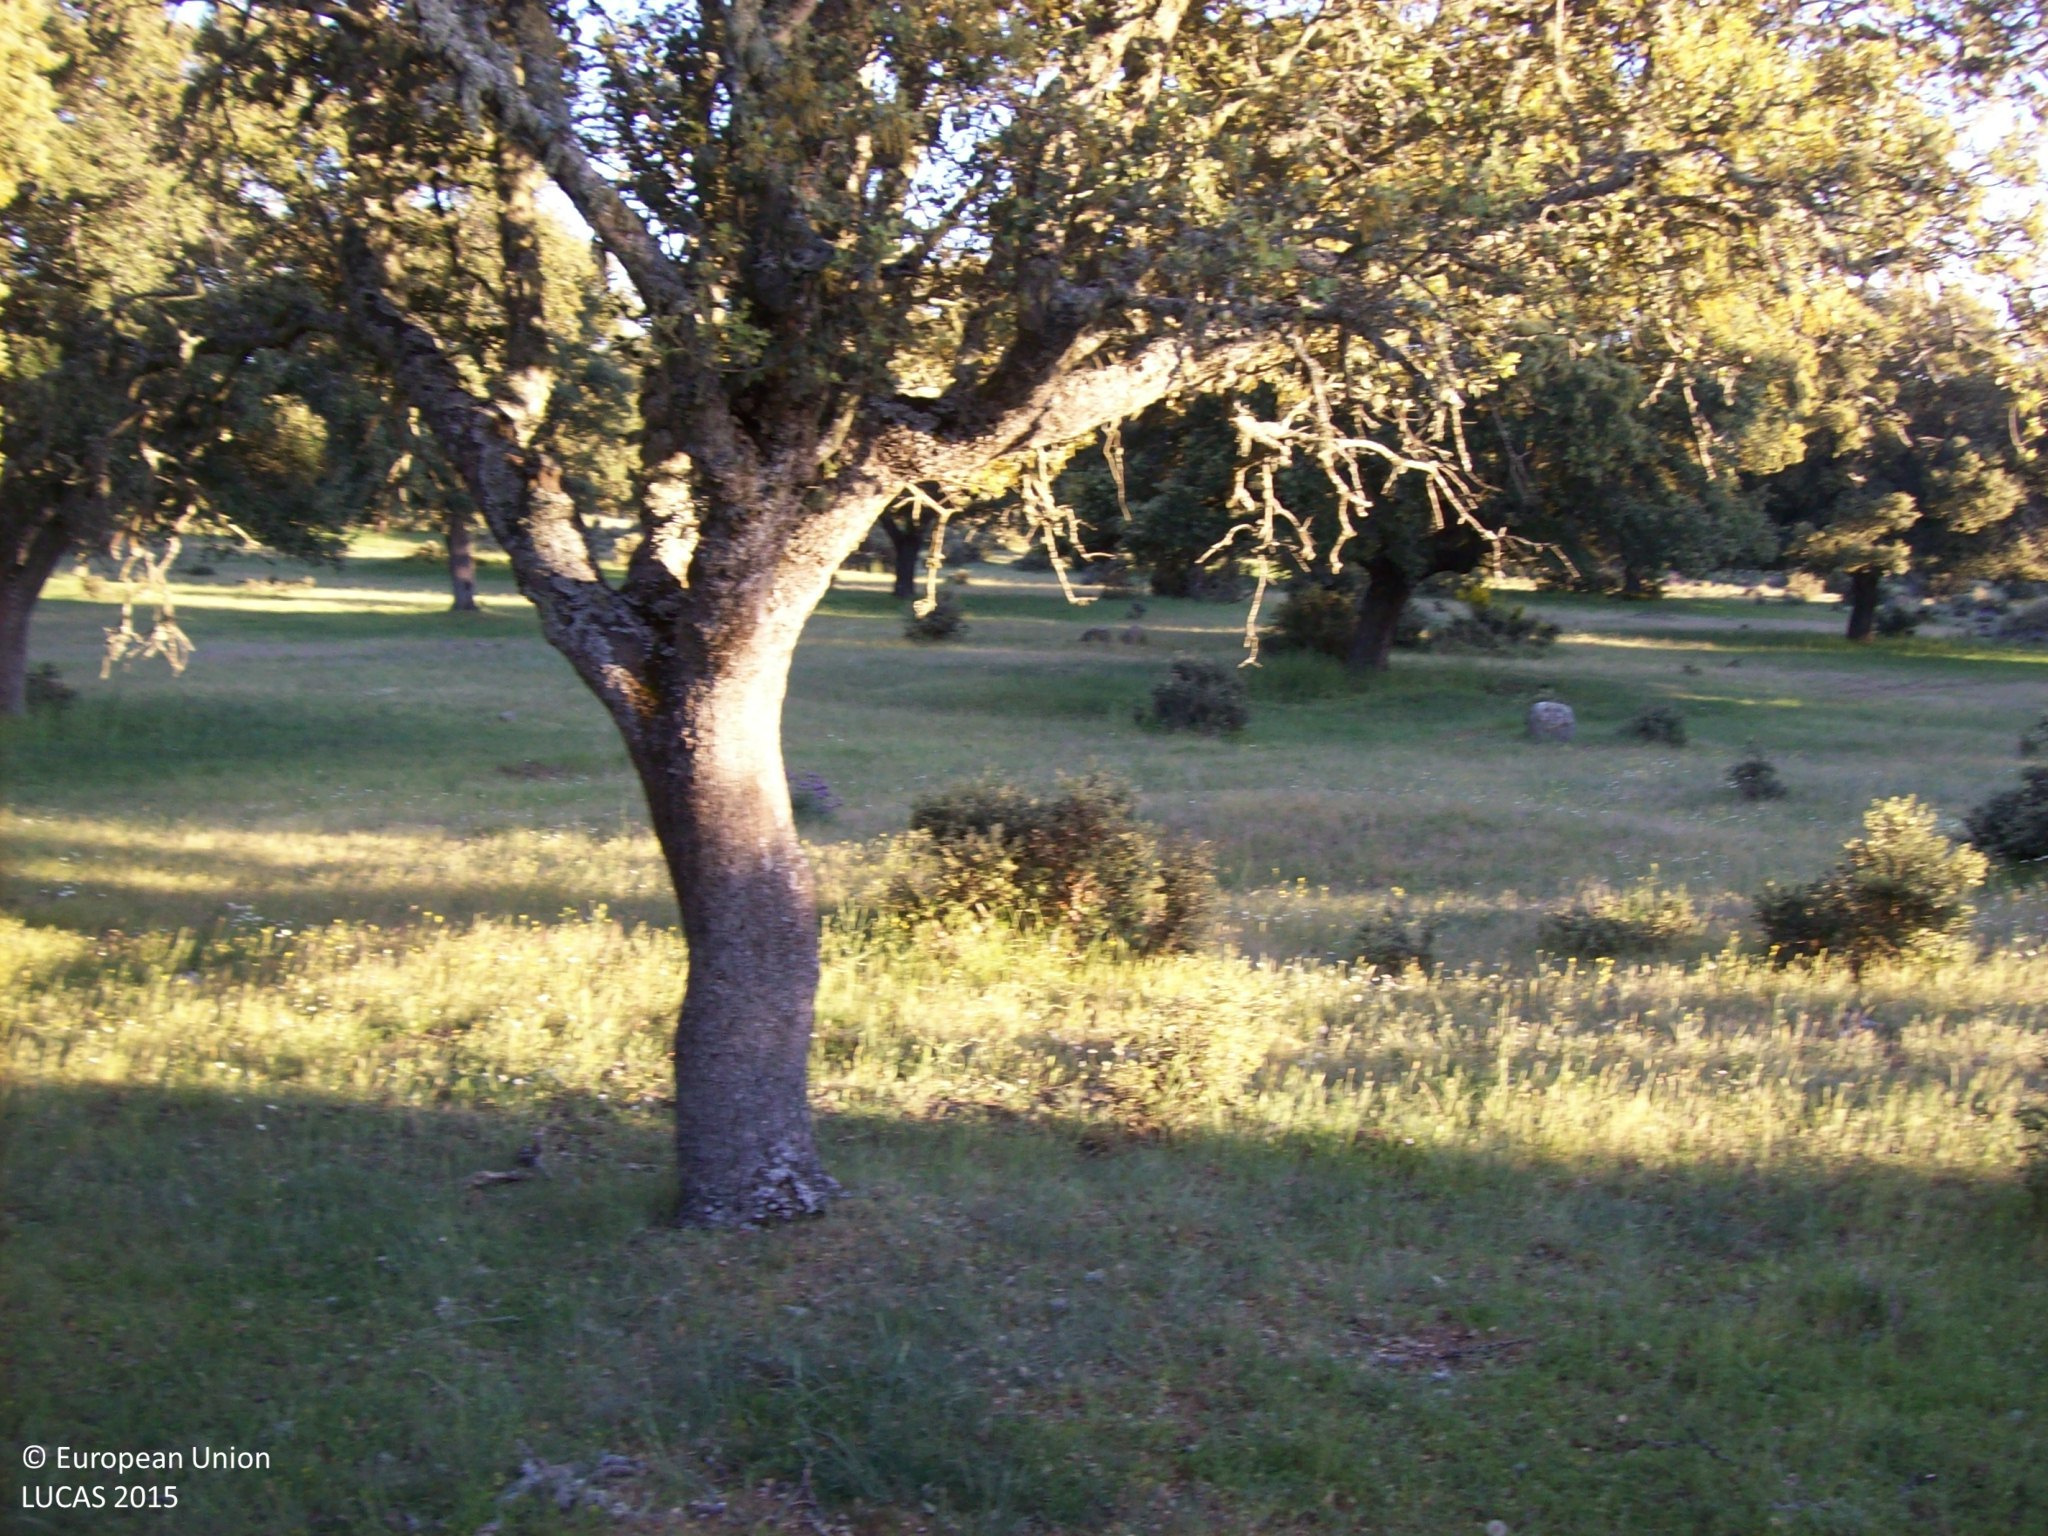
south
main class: Woodland
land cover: Broadleaved woodland
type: broadleaved evergreen forest
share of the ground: 50 - 75 %
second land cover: Grassland without tree/shrub cover
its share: > 75 %
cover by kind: broadleaved forest trees 50 %, herbaceous plants 45 %, consolidated bare surface 5 %
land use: Forestry
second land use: Agriculture (excluding fallow land and kitchen gardens)
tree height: > 5 m
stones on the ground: < 10 %
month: May
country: ES
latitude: 40.6812
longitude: -5.1489
